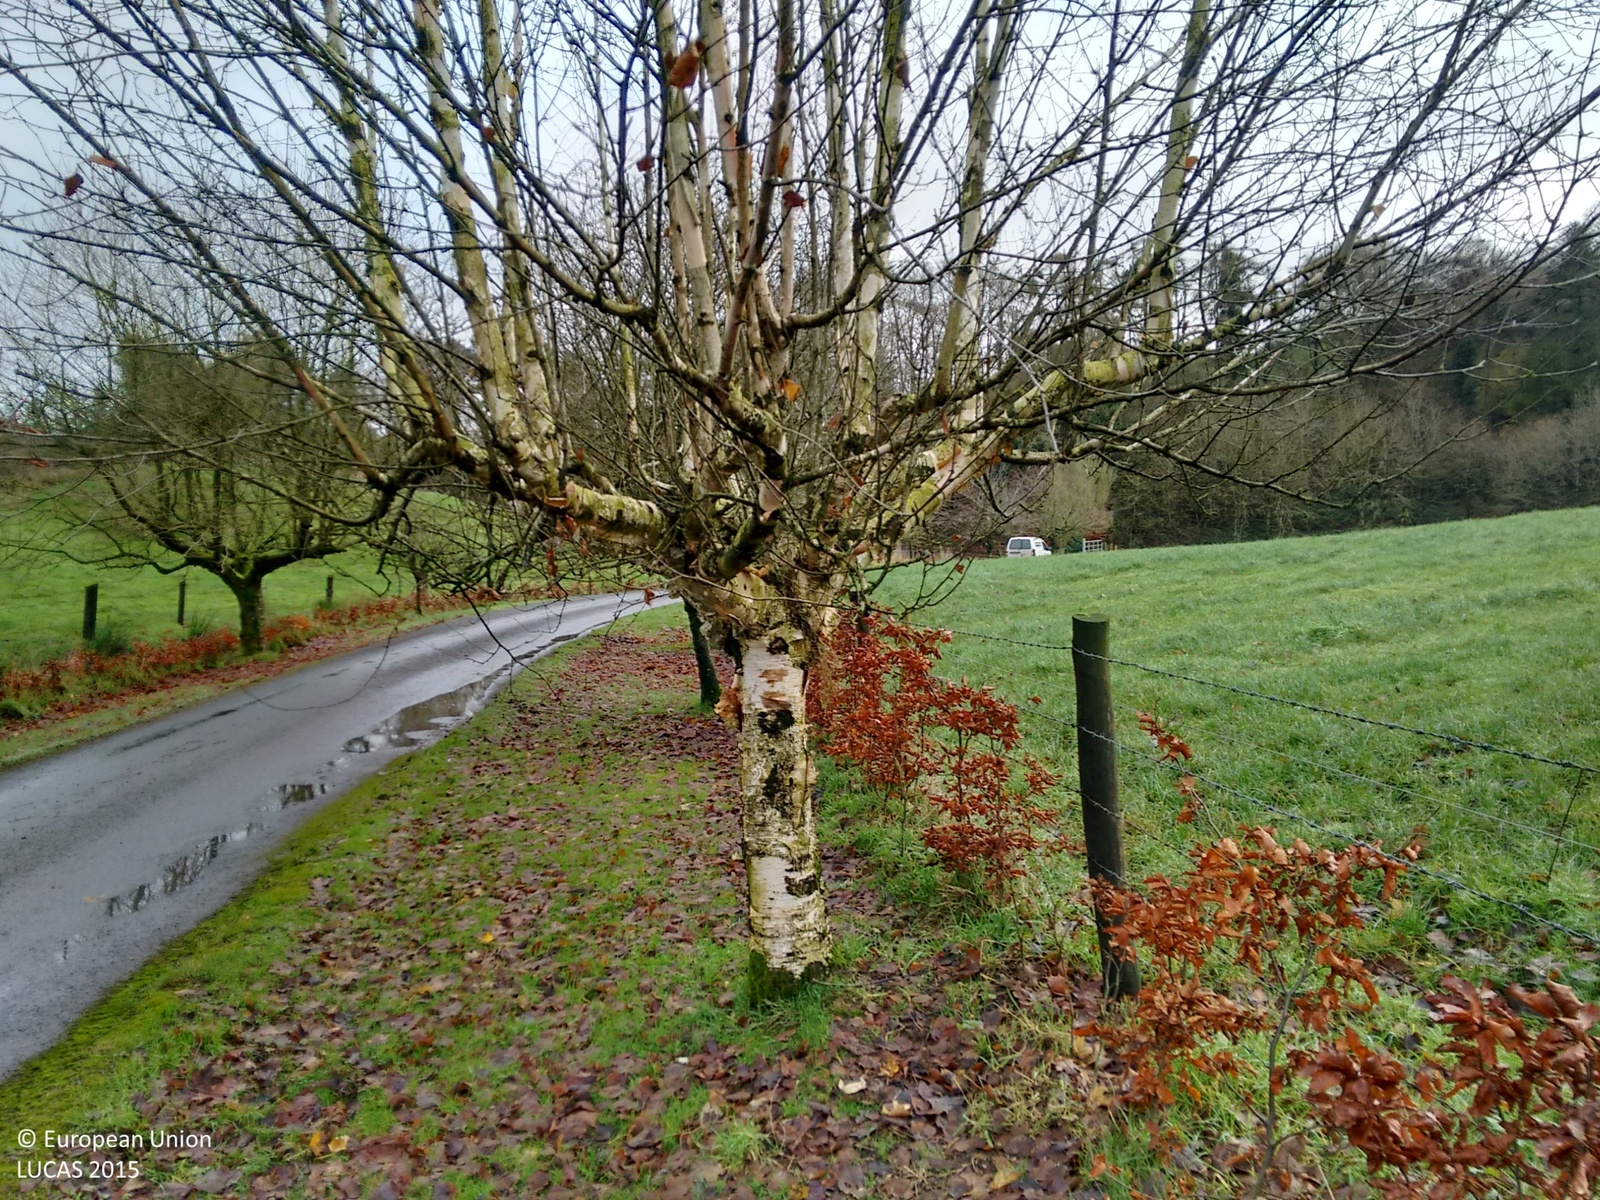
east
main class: Woodland
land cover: Broadleaved woodland
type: acidophilous oak and oak-birch forest
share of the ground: > 75 %
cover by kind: broadleaved forest trees 95 %, shrubs 5 %
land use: Semi-natural and natural areas not in use
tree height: > 5 m
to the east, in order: Broadleaved woodland; Fences; Grassland without tree/shrub cover
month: December
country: IE
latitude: 53.9834
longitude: -7.1804
